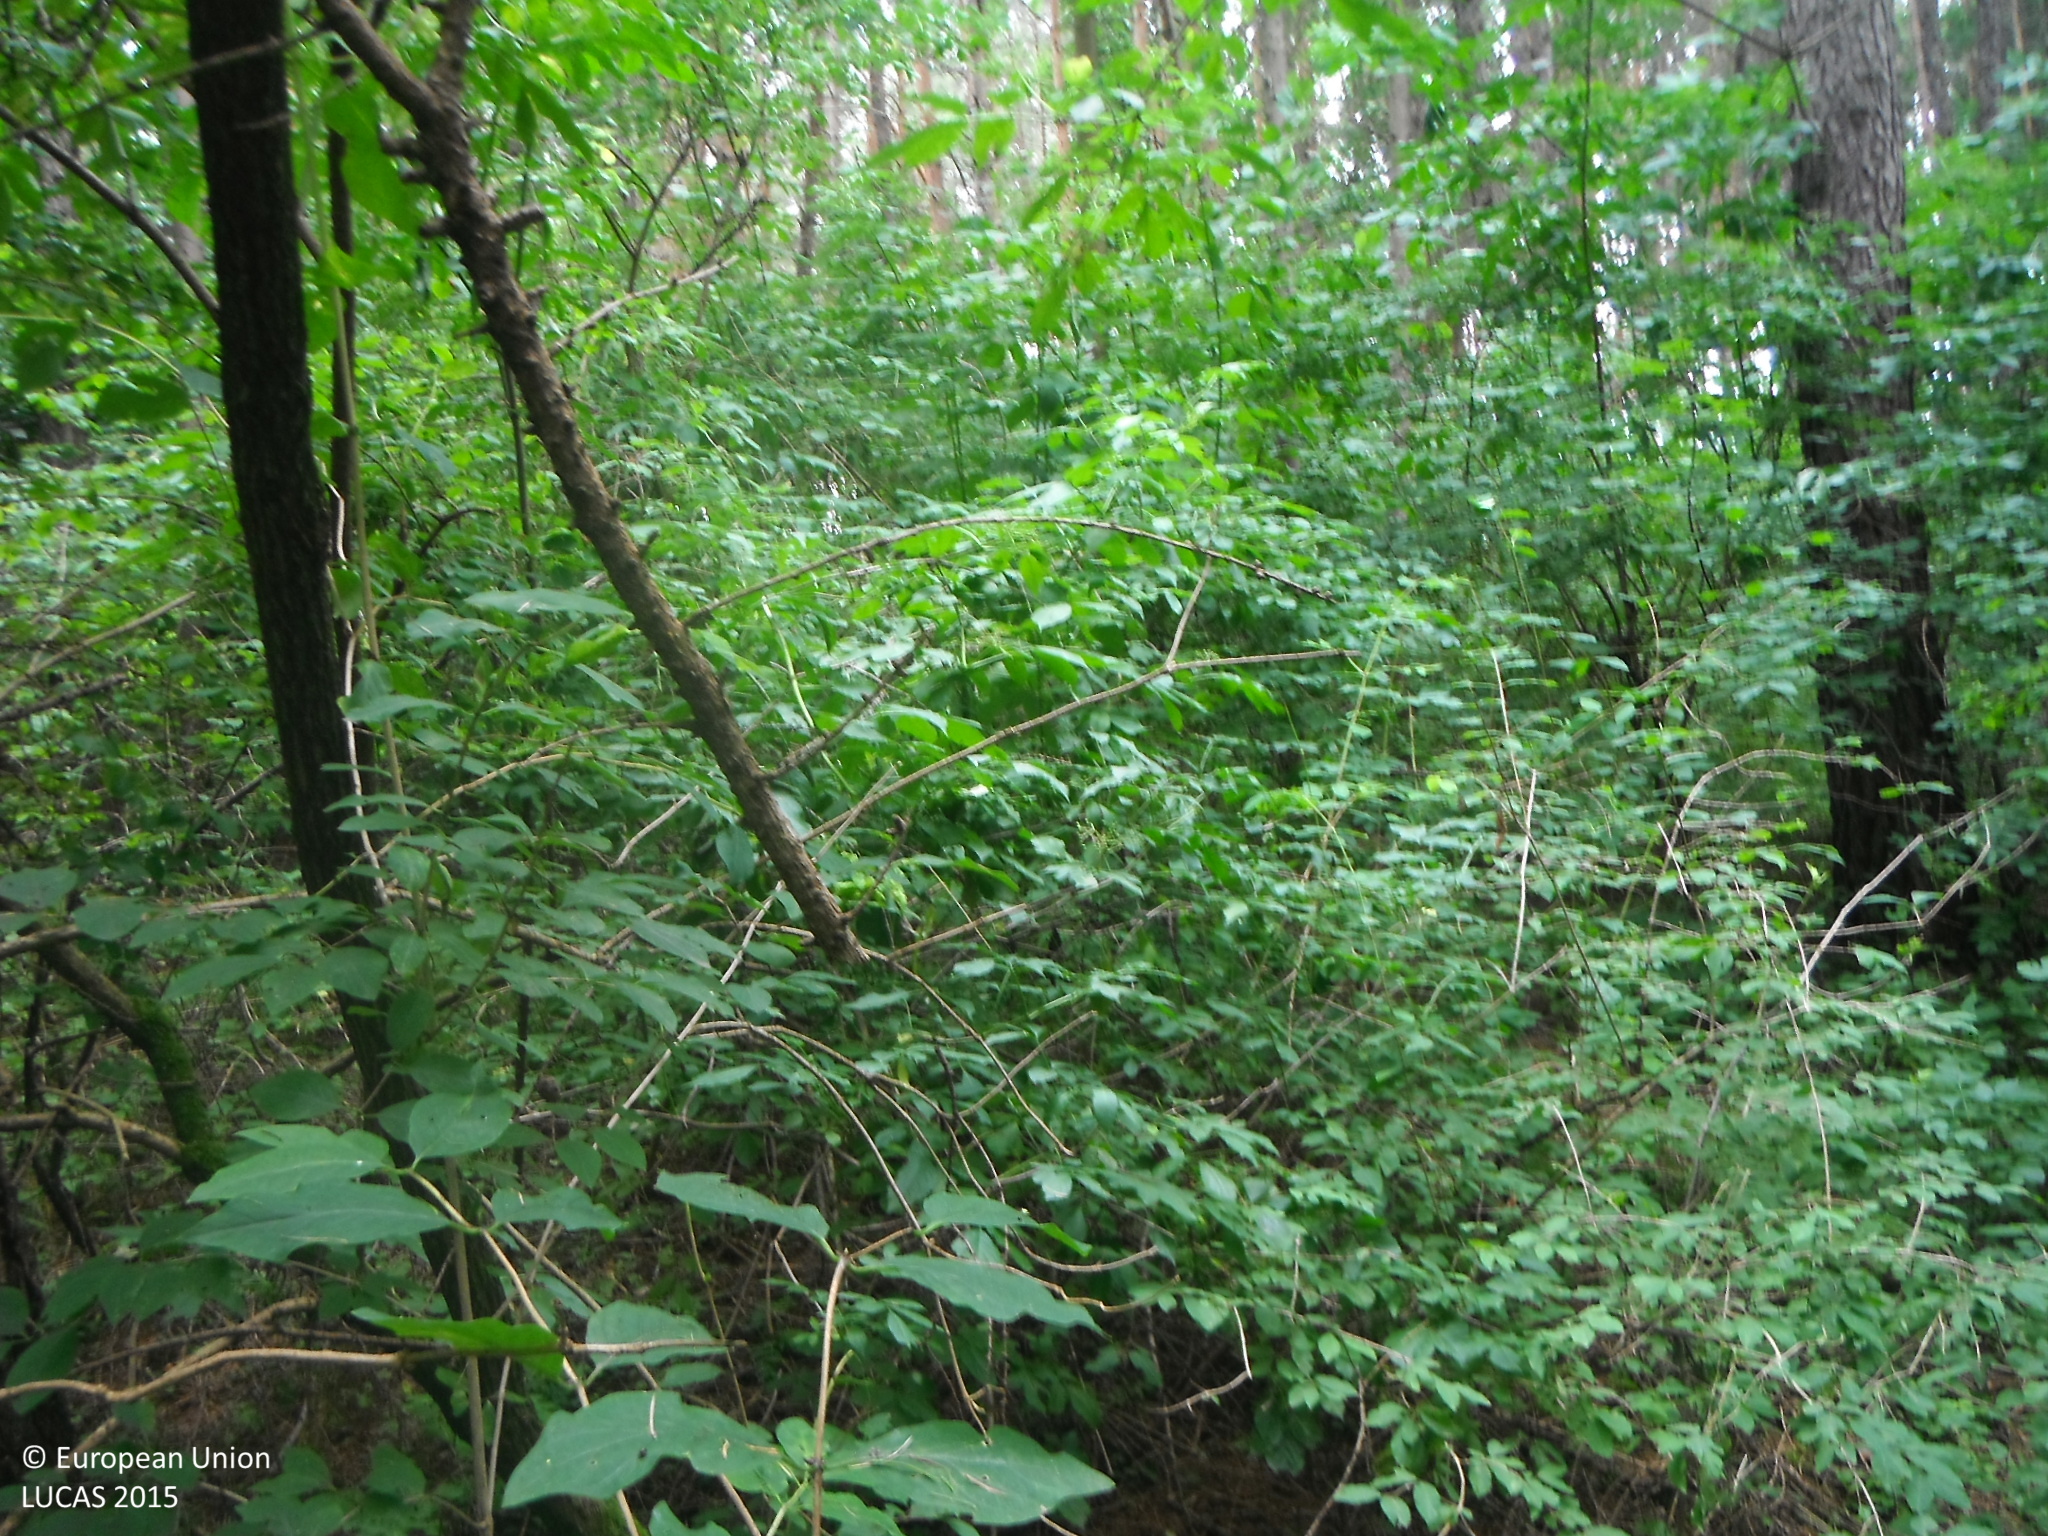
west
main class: Woodland
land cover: Other mixed woodland
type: hemiboreal forest and nemoral coniferous forest and mixed broadleaved-coniferous forest
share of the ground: > 75 %
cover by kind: coniferous forest trees 65 %, broadleaved forest trees 35 %
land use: Amenities, museums, leisure
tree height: > 5 m
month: July
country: SK
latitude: 49.0270
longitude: 20.3048
